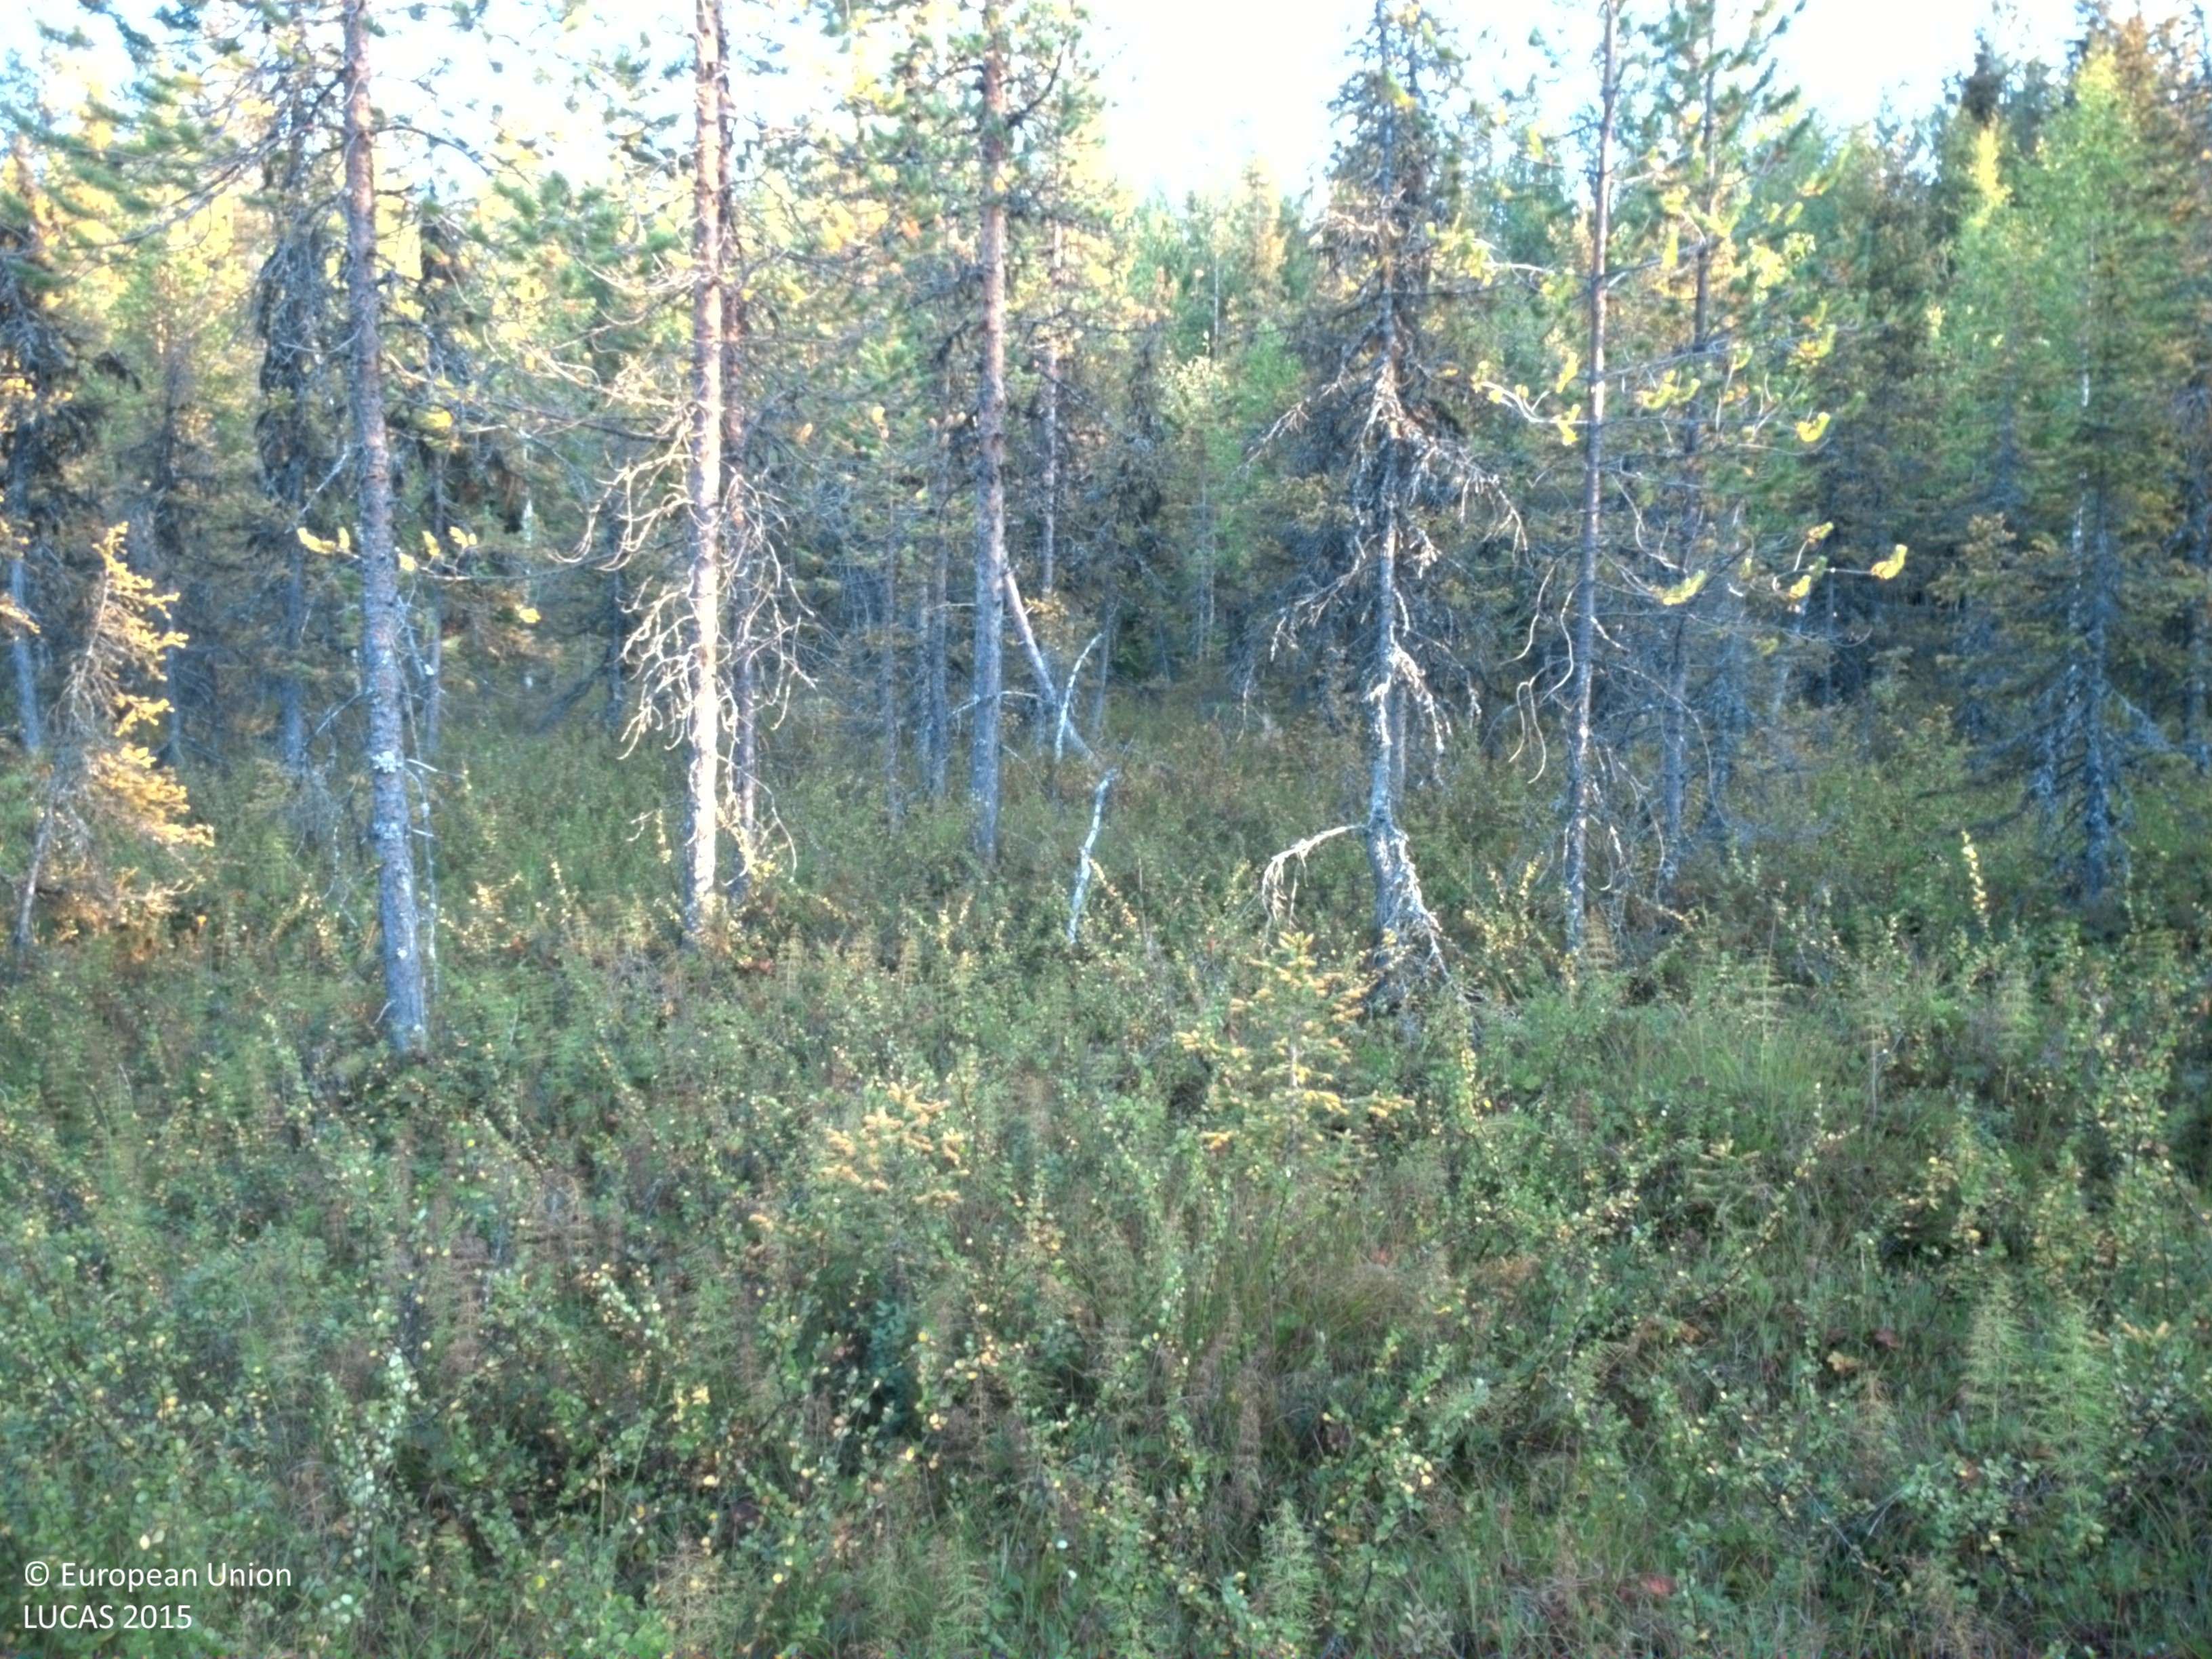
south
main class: Woodland
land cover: Spruce dominated coniferous woodland
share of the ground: 25 - 50 %
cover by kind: shrubs 70 %, coniferous forest trees 30 %
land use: Forestry
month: August
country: SE
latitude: 66.7285
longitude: 19.9996
